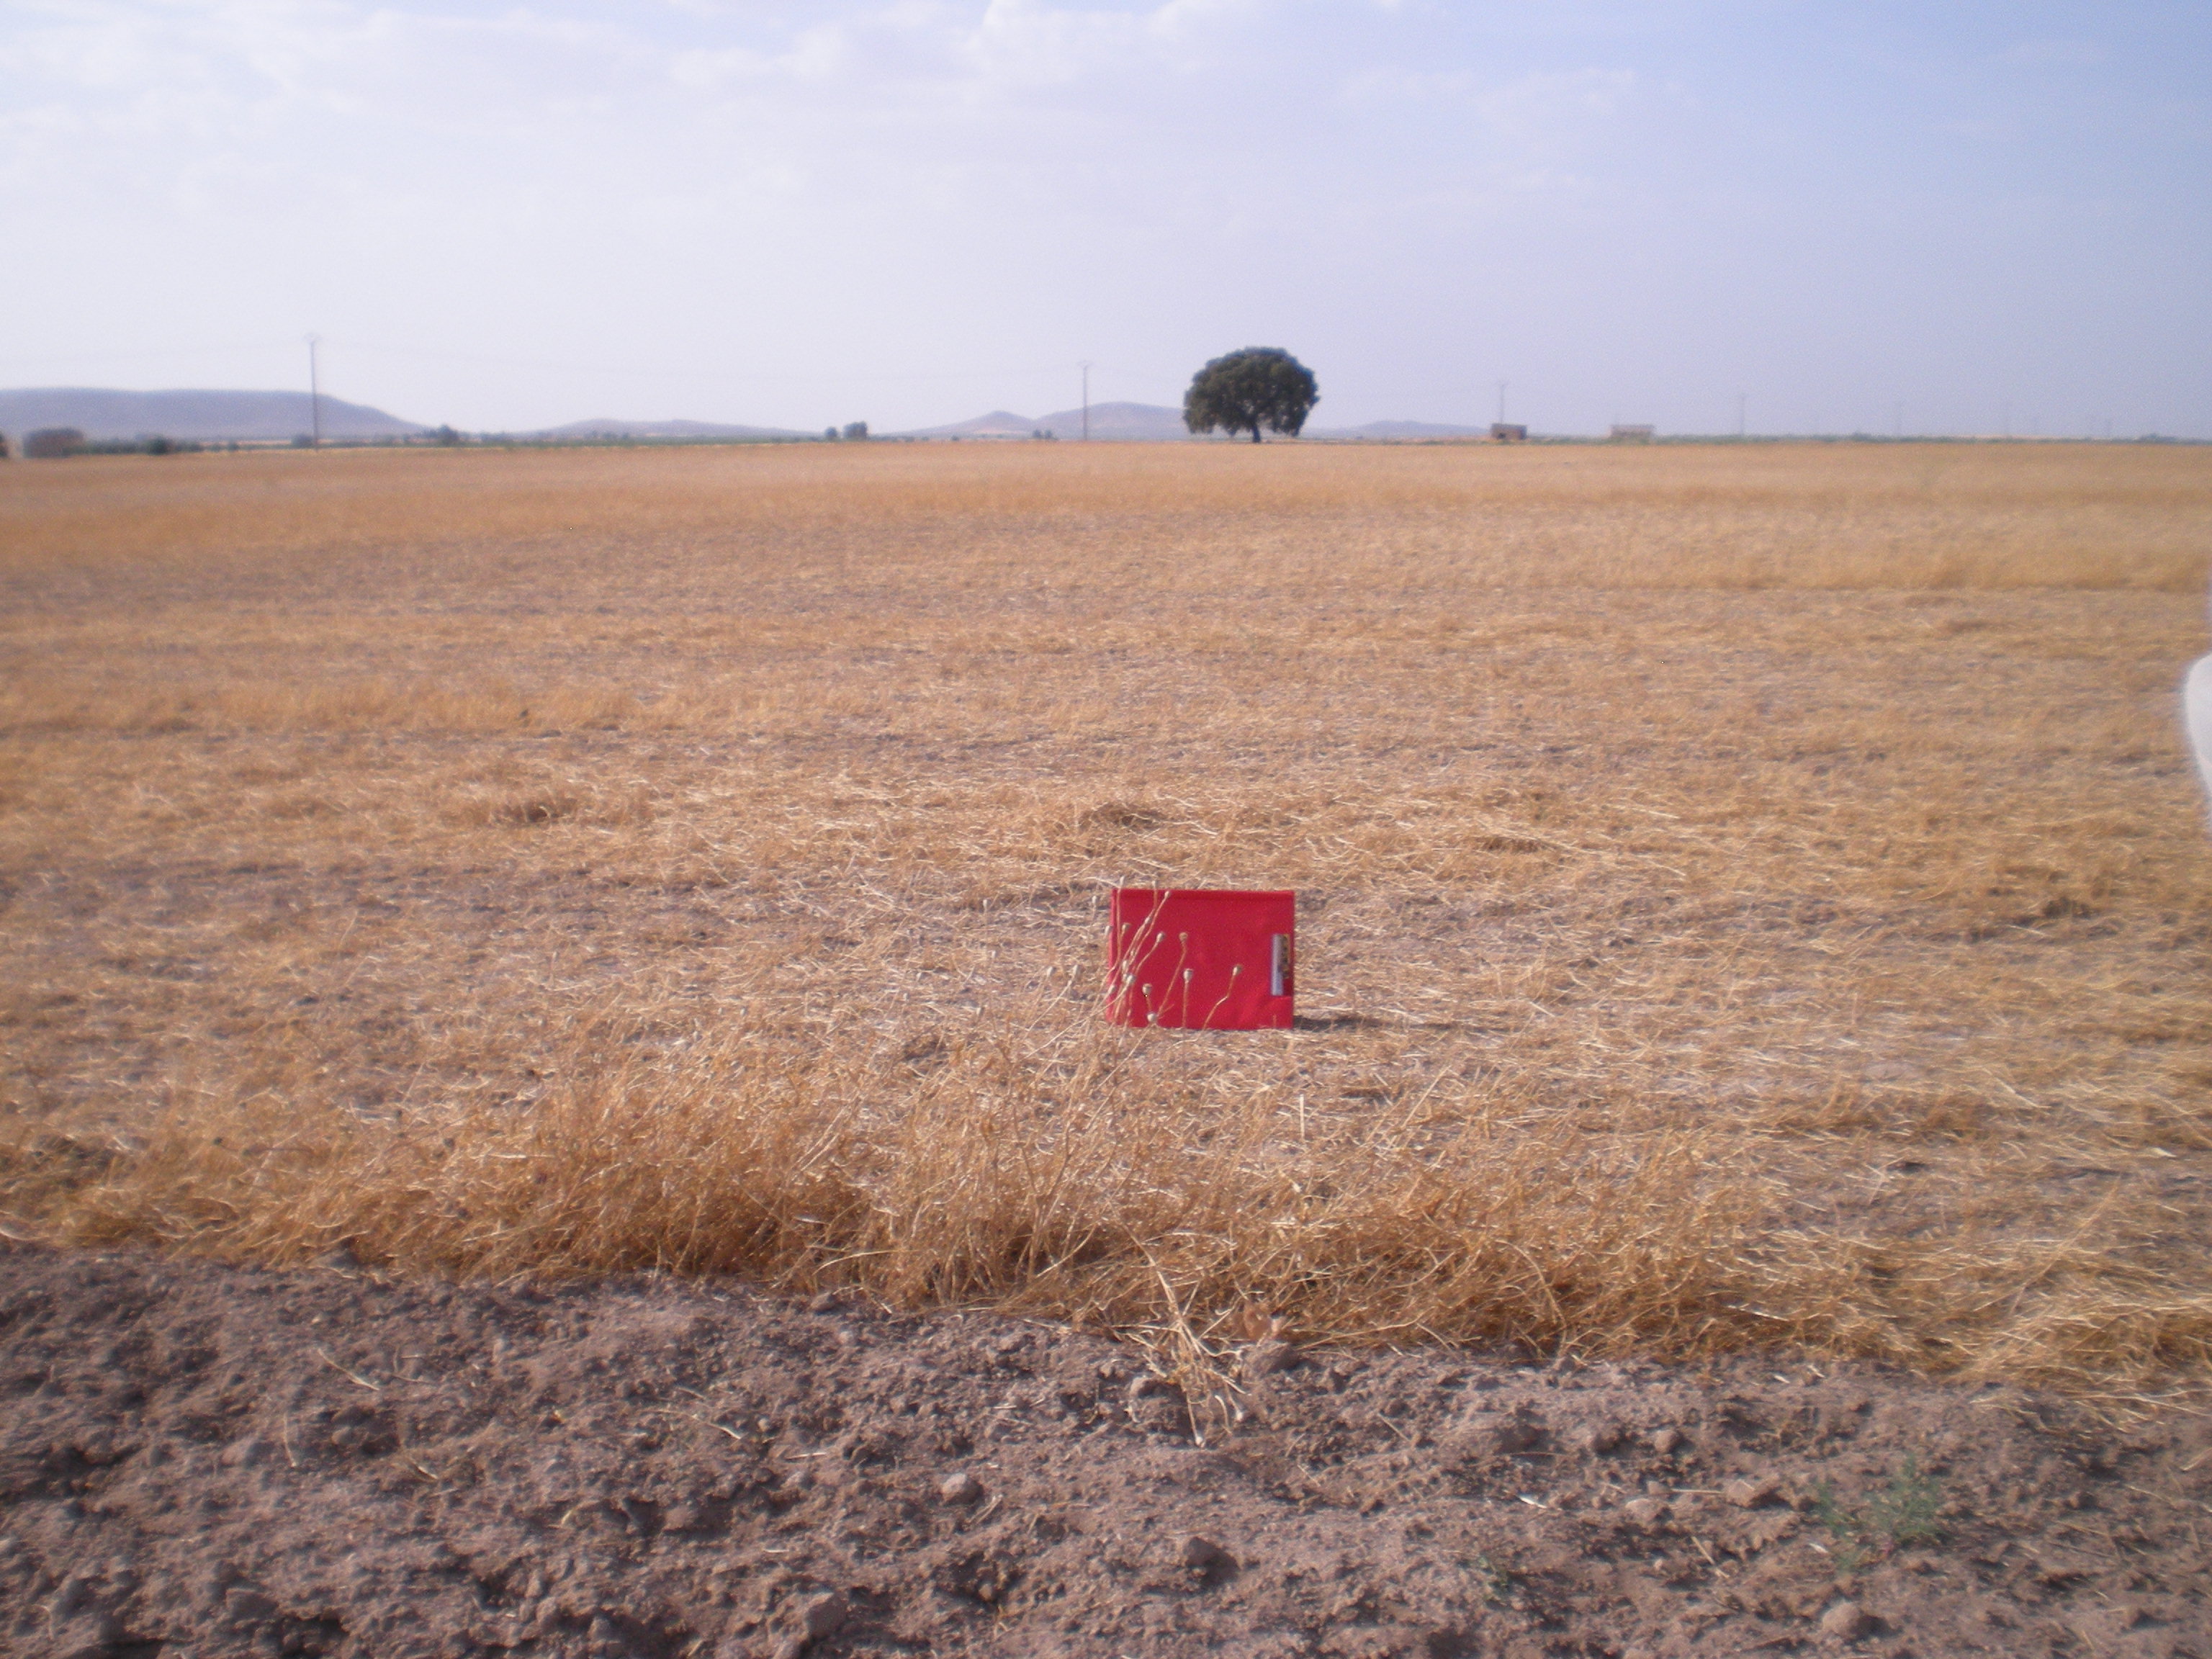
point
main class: Cropland
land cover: Dry pulses
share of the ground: < 10 %
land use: Agriculture (excluding fallow land and kitchen gardens)
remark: Harvested field
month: July
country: ES
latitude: 39.2612
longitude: -3.3337
